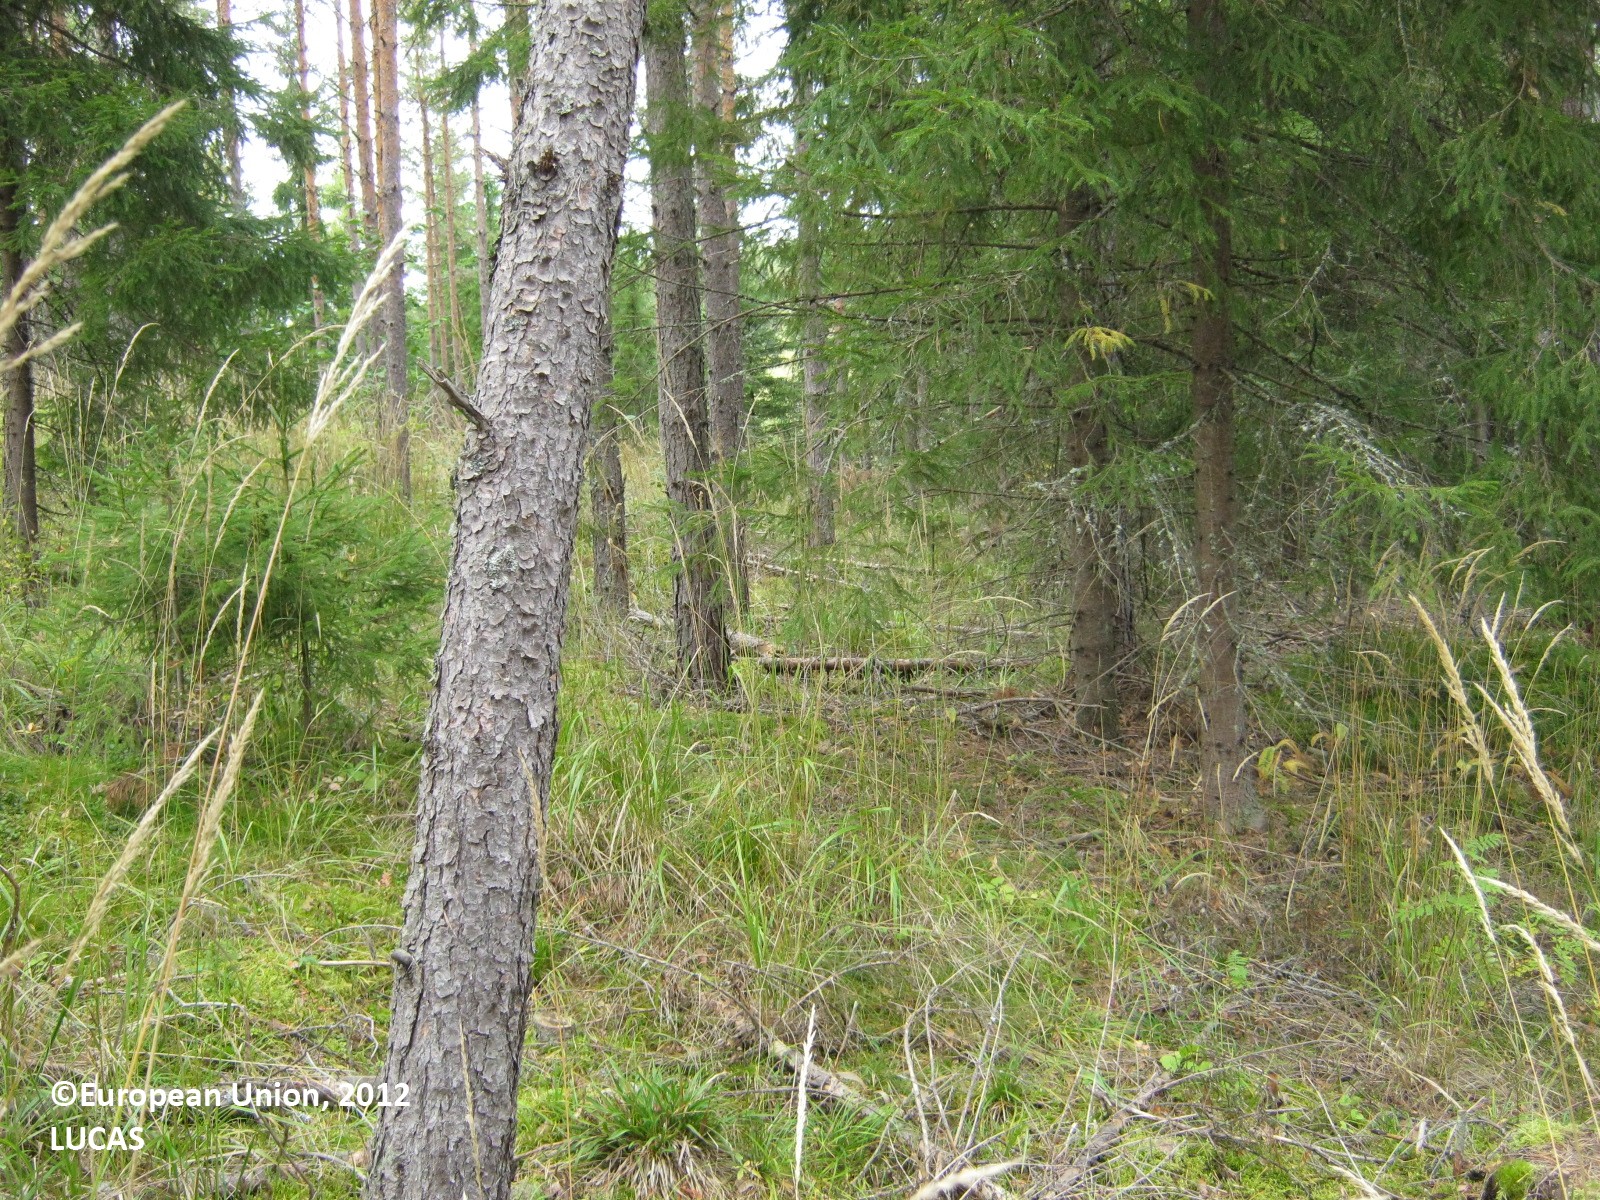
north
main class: Woodland
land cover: Pine dominated coniferous woodland
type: boreal forest
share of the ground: > 75 %
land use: Forestry
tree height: > 5 m
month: September
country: FI
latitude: 60.7371
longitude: 27.6677
